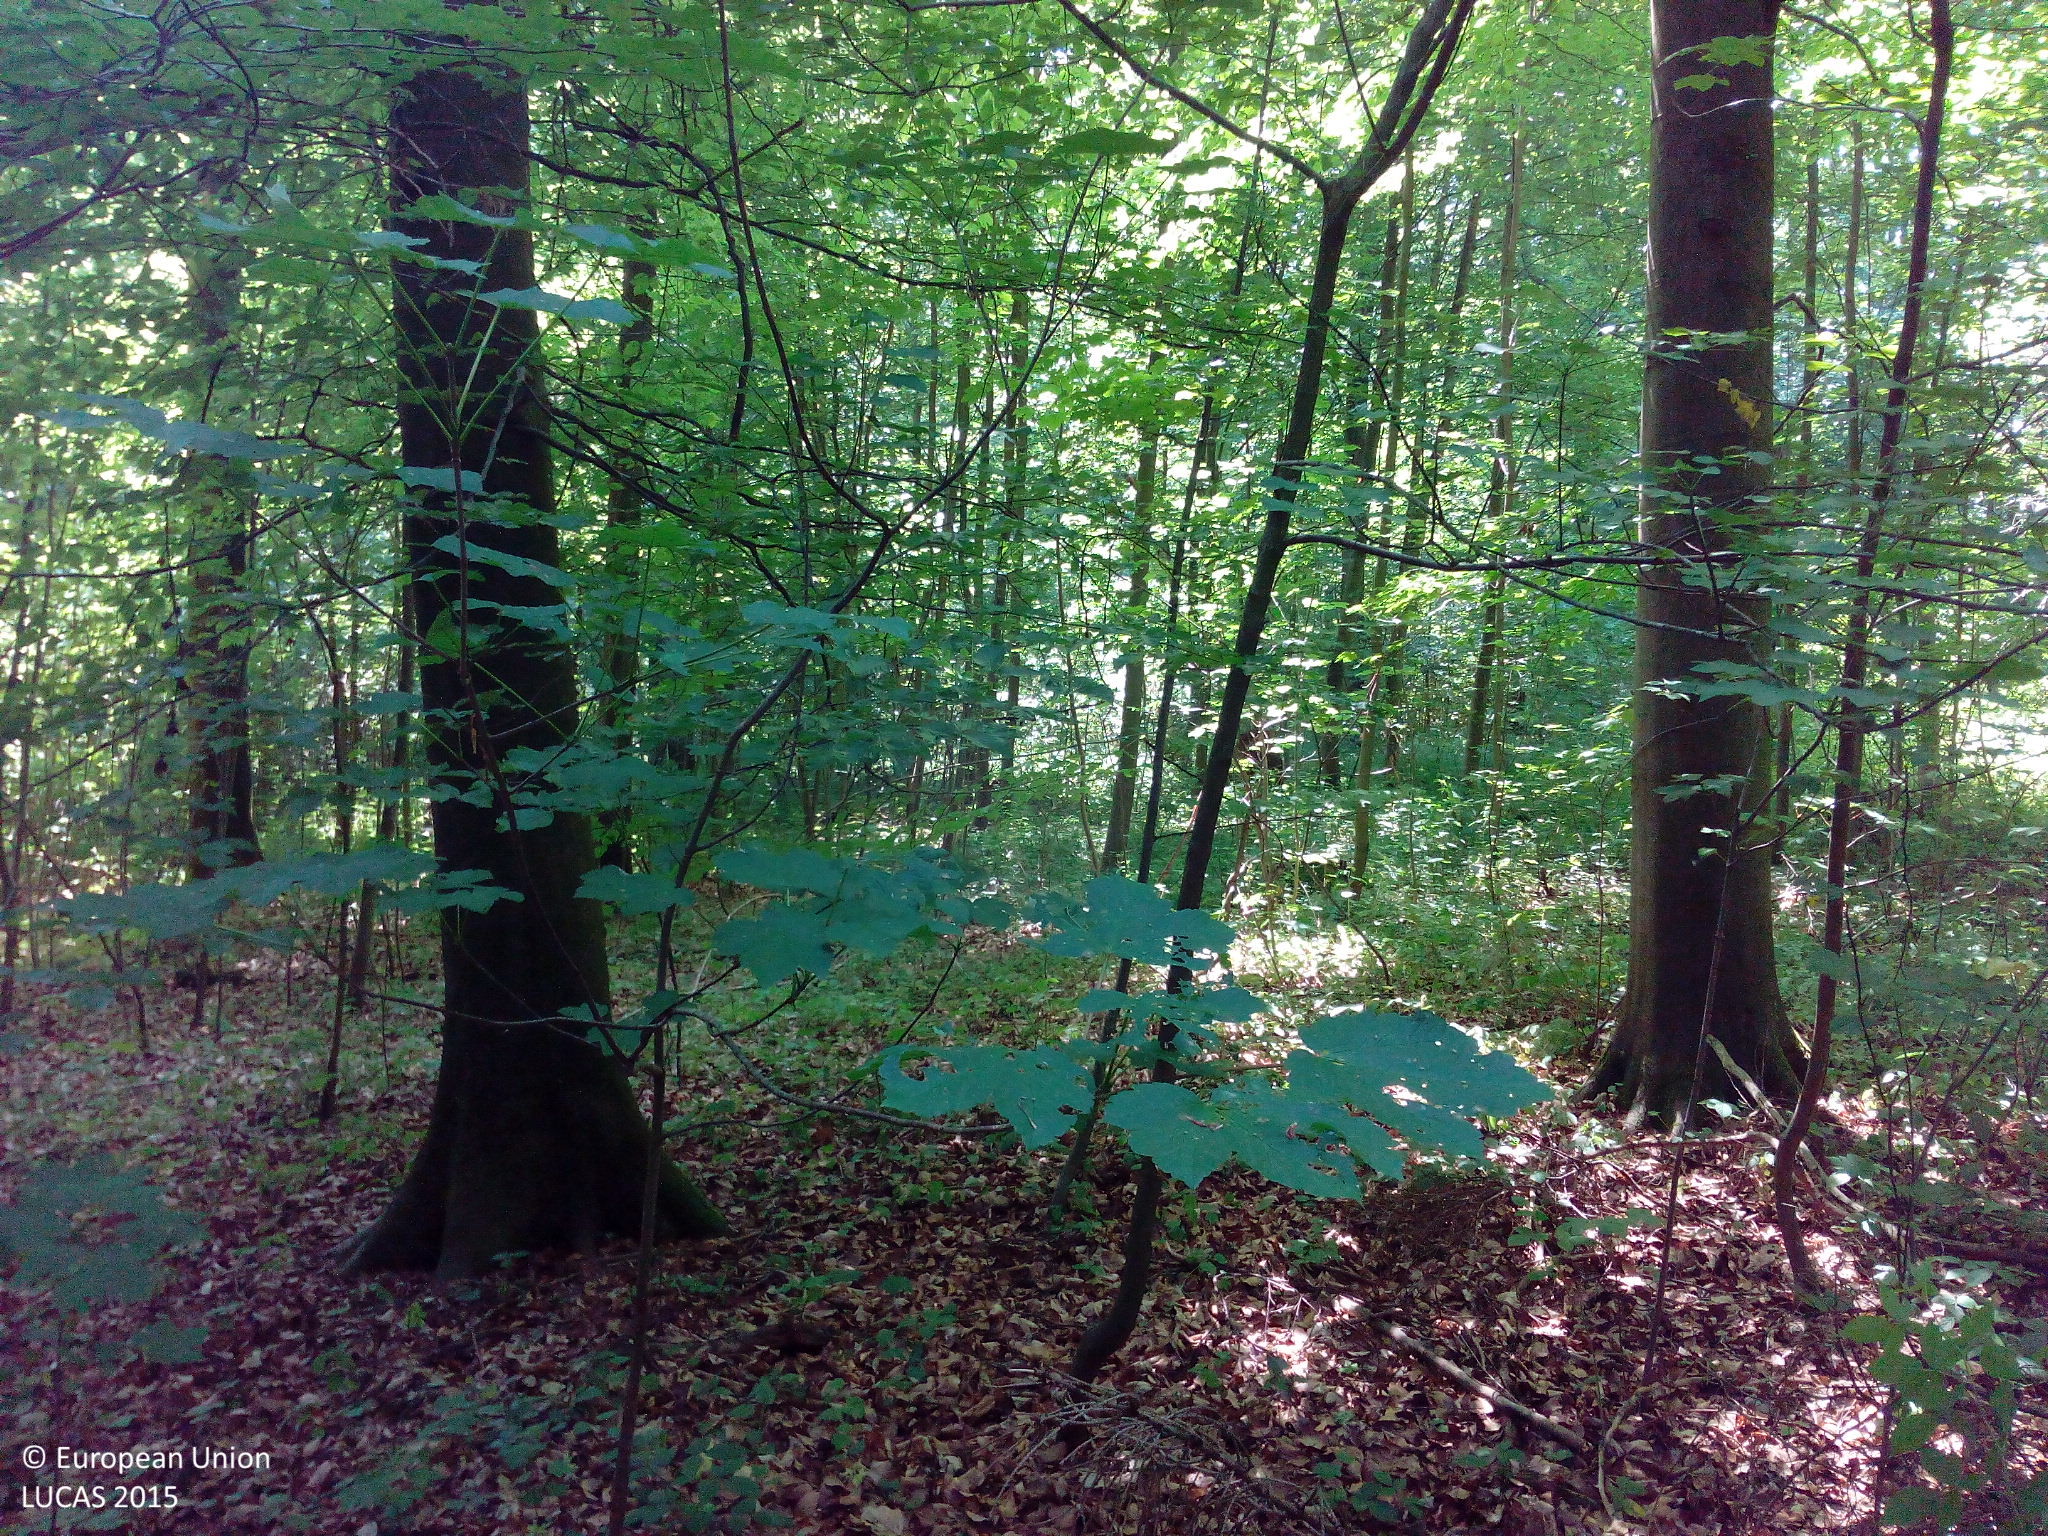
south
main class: Woodland
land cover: Pine dominated mixed woodland
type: hemiboreal forest and nemoral coniferous forest and mixed broadleaved-coniferous forest
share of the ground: > 75 %
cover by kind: broadleaved forest trees 65 %, coniferous forest trees 25 %, shrubs 5 %, herbaceous plants 5 %
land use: Forestry
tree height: > 5 m
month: July
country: DE
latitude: 49.5547
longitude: 9.9033
